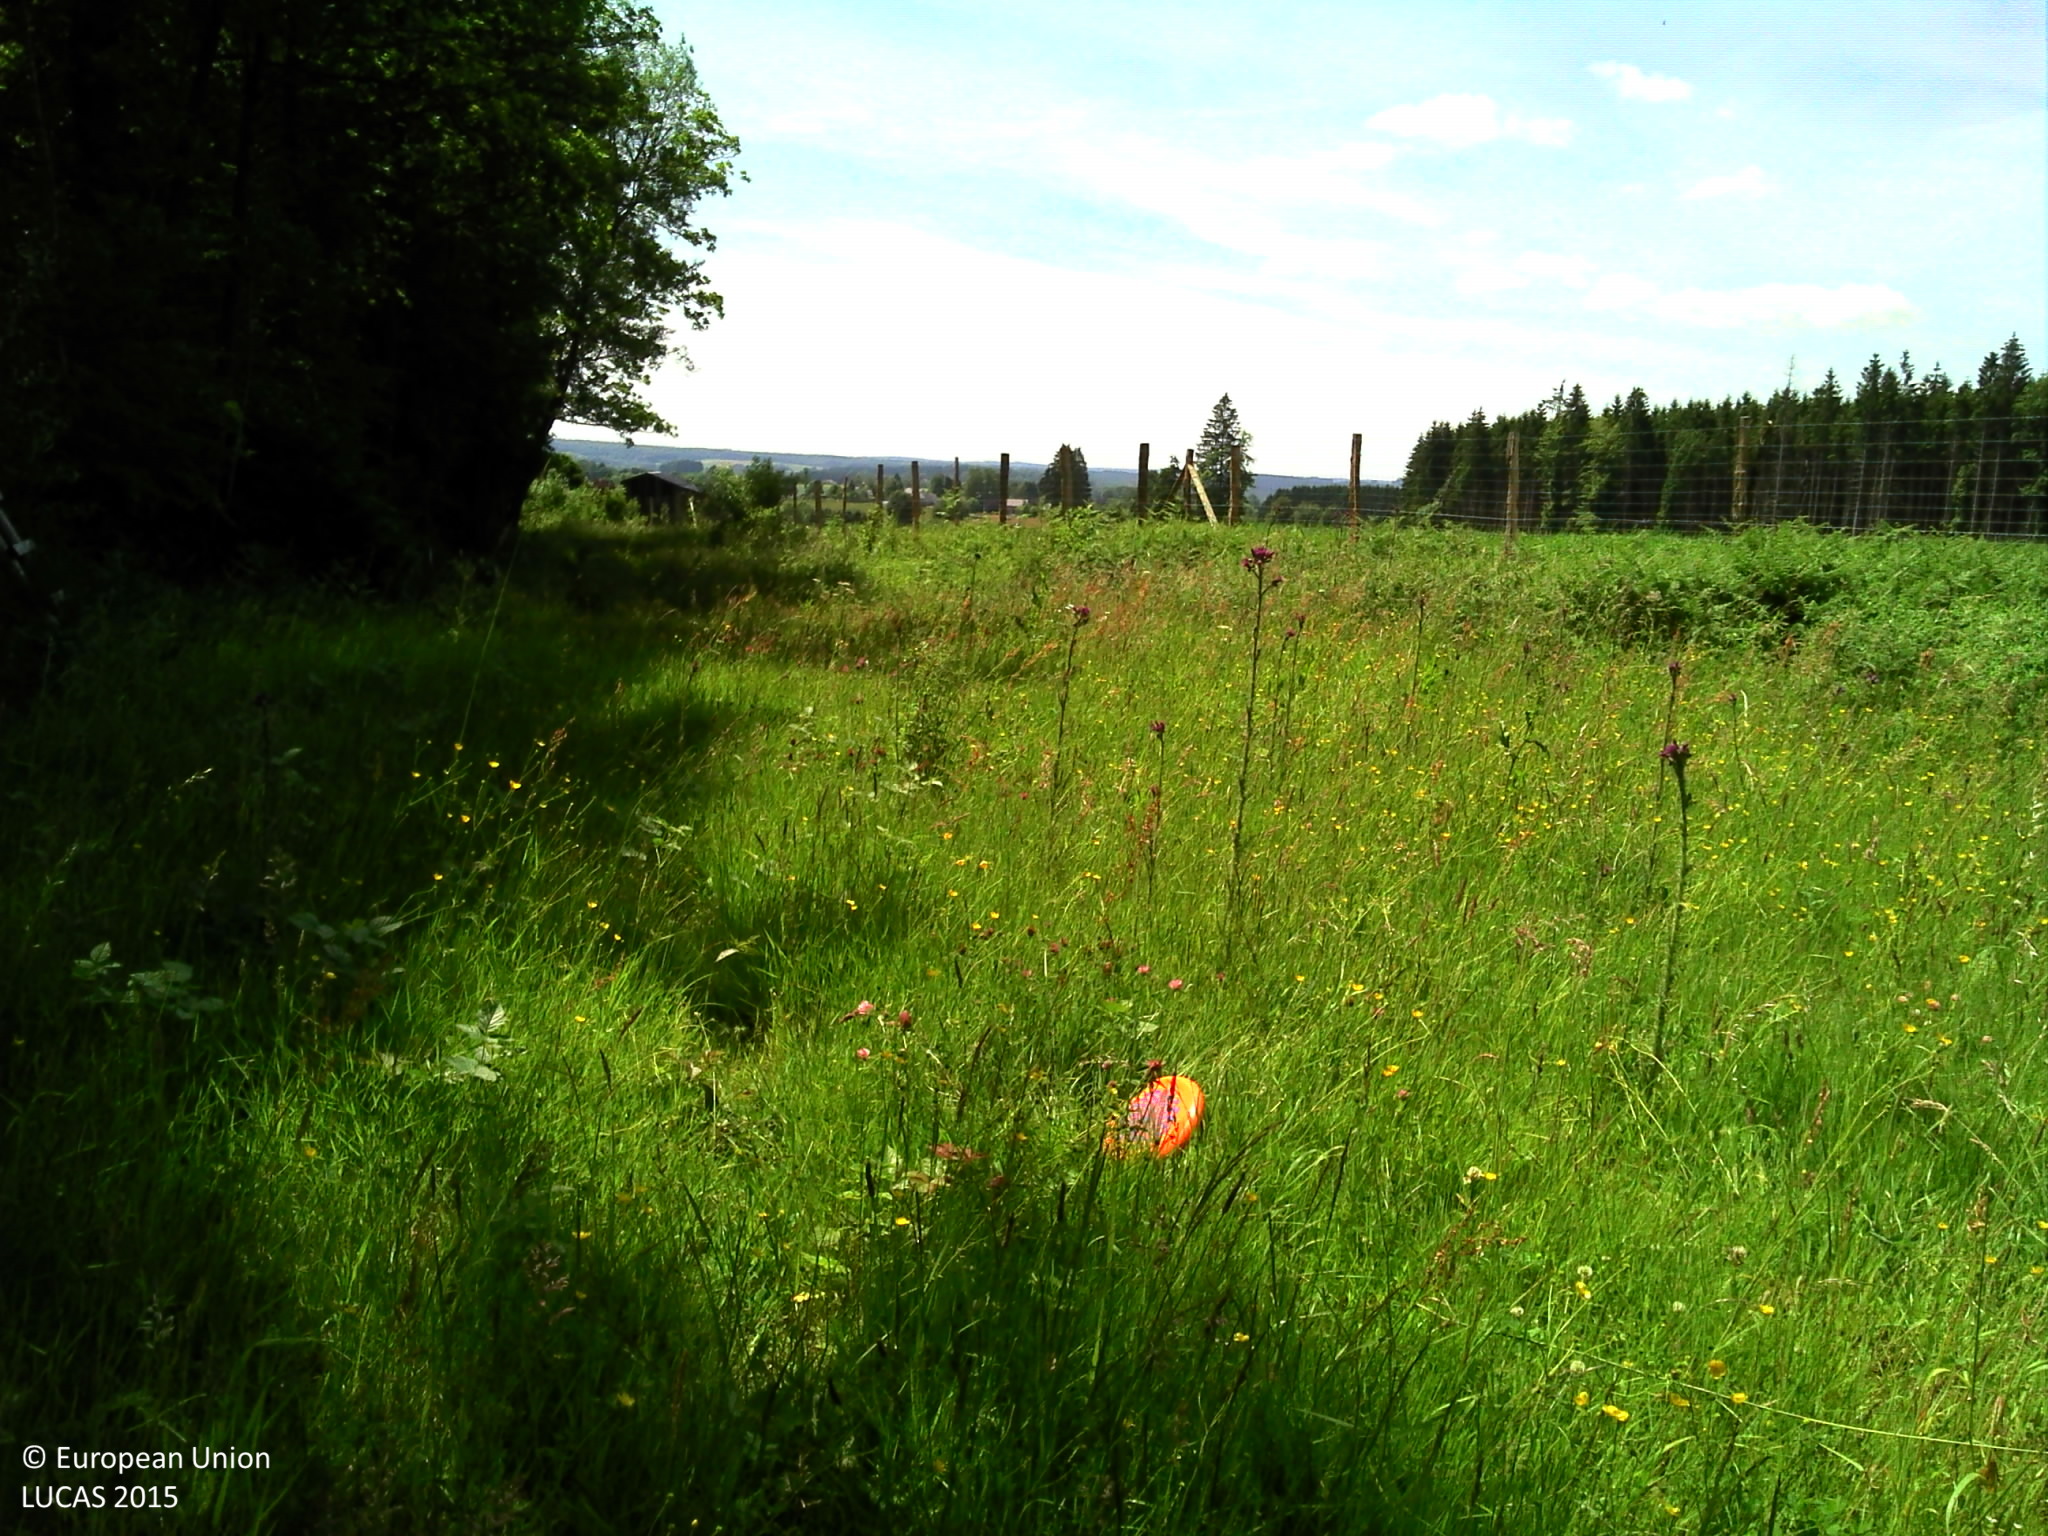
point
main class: Grassland
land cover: Spontaneously vegetated surfaces
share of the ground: > 75 %
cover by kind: herbaceous plants 100 %
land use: Forestry
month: June
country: BE
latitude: 49.9960
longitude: 5.2688
